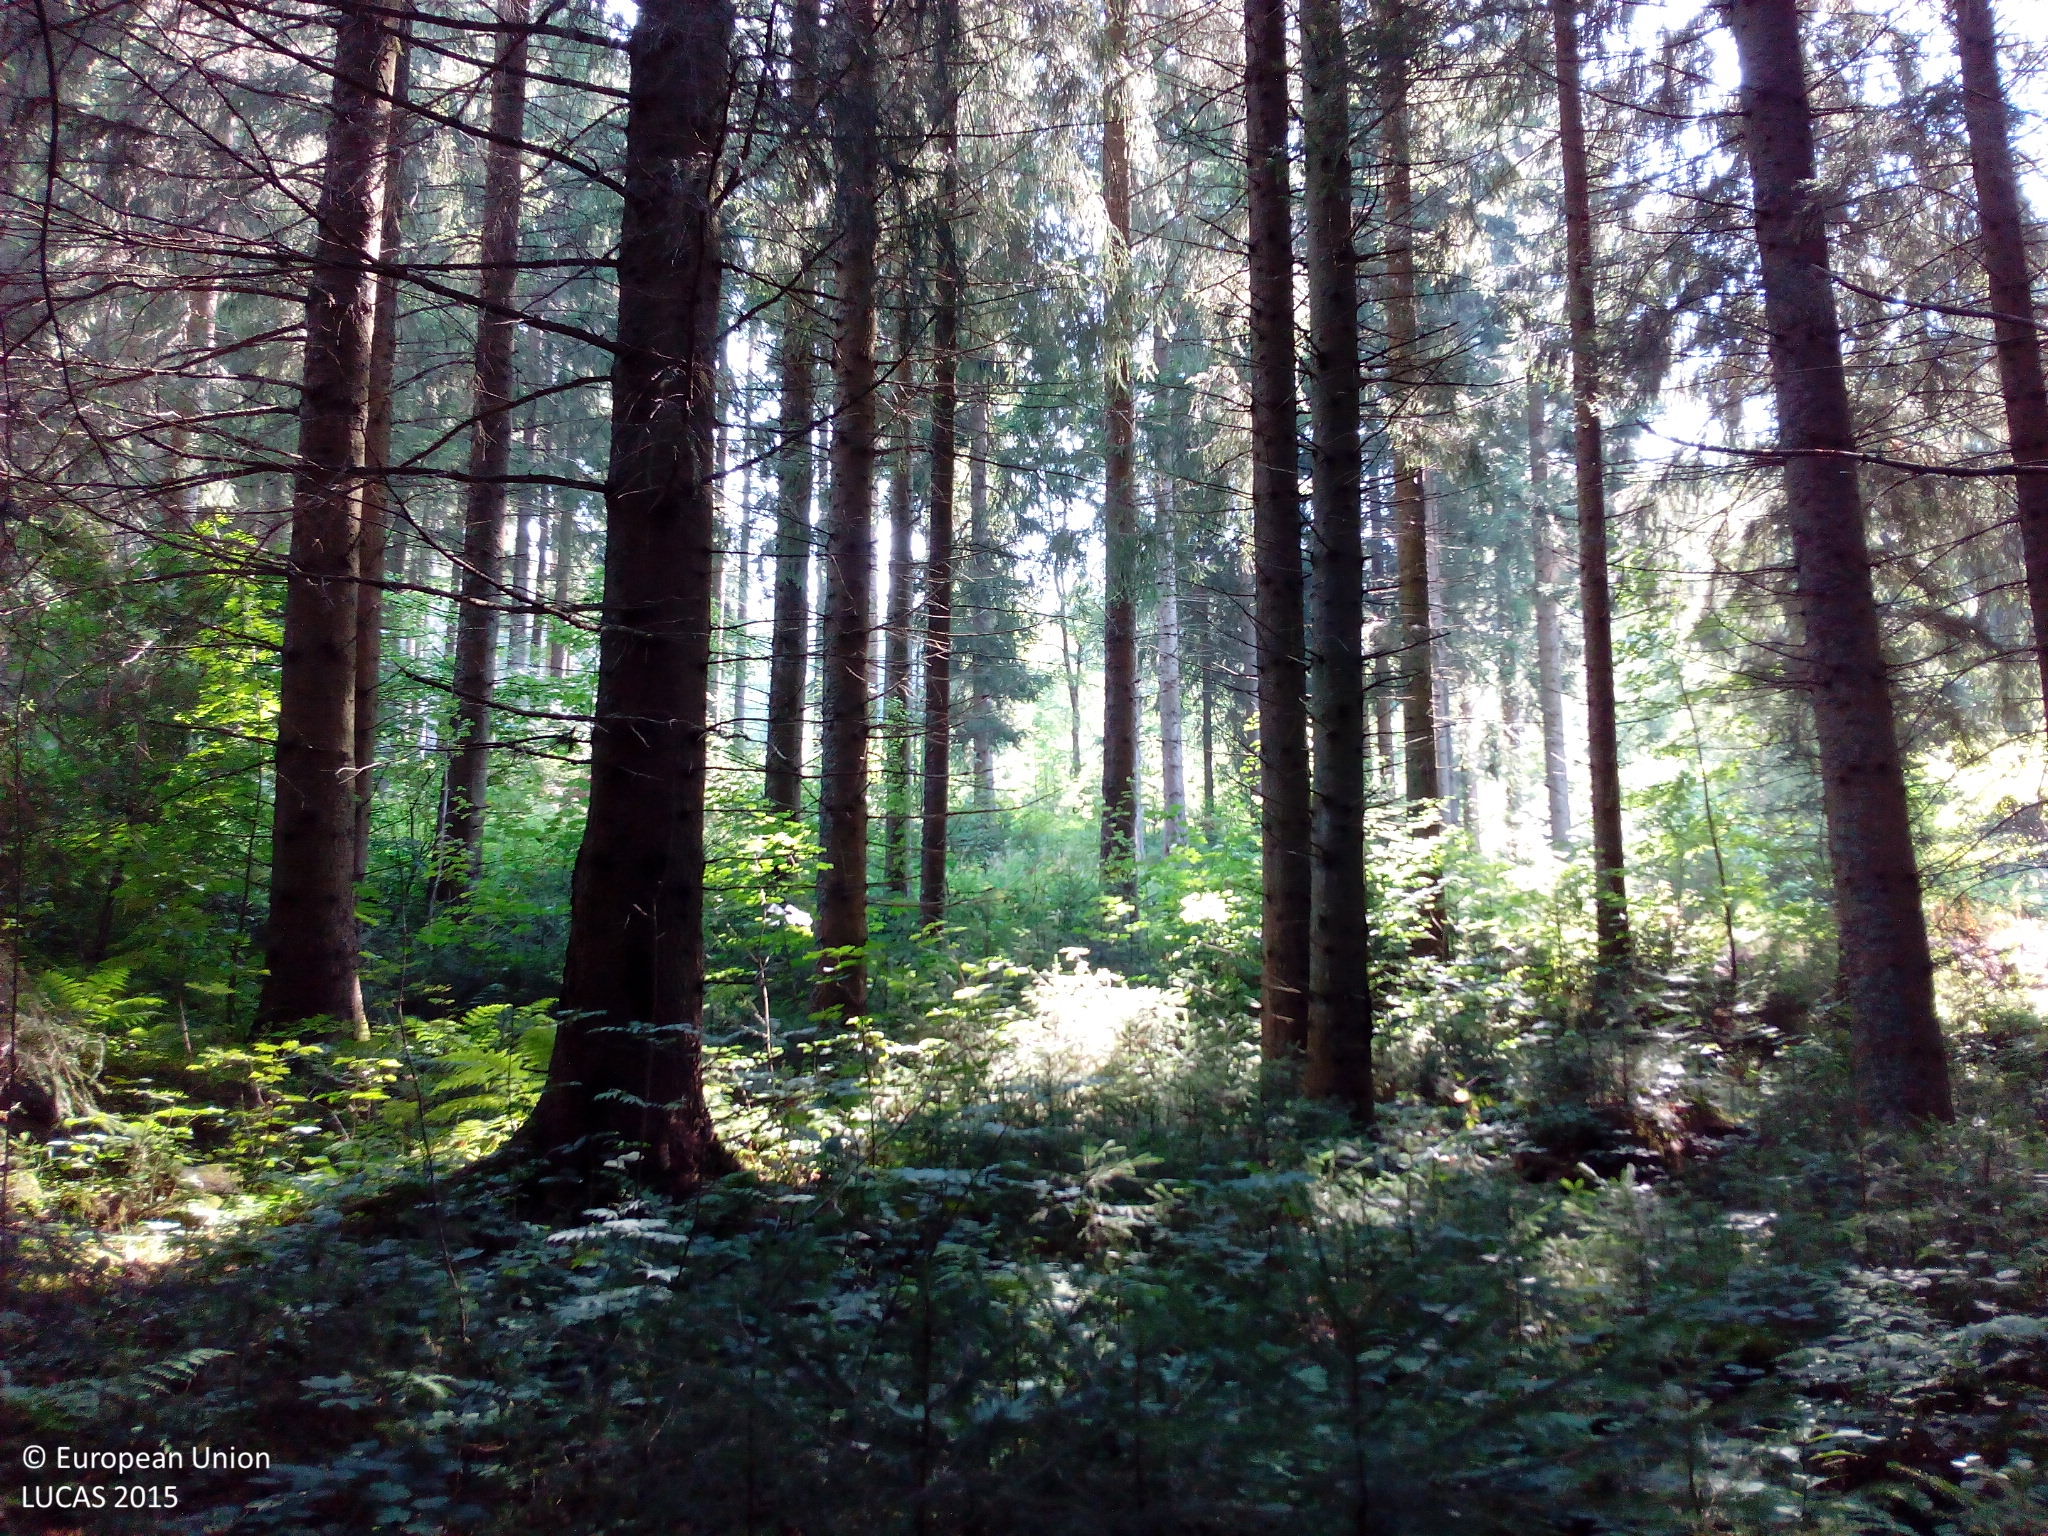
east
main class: Woodland
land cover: Spruce dominated coniferous woodland
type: hemiboreal forest and nemoral coniferous forest and mixed broadleaved-coniferous forest
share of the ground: > 75 %
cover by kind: coniferous forest trees 70 %, broadleaved forest trees 10 %, herbaceous plants 10 %, lichens and mosses 5 %, unconsolidated bare surface 5 %
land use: Forestry
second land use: Amenities, museums, leisure
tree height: > 5 m
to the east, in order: Spruce dominated coniferous woodland; Grass margins; Tracks; Grass margins; Spruce dominated coniferous woodland; Broadleaved woodland; Spruce dominated mixed woodland; Spruce dominated coniferous woodland
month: August
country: DE
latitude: 47.8299
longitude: 8.1443
